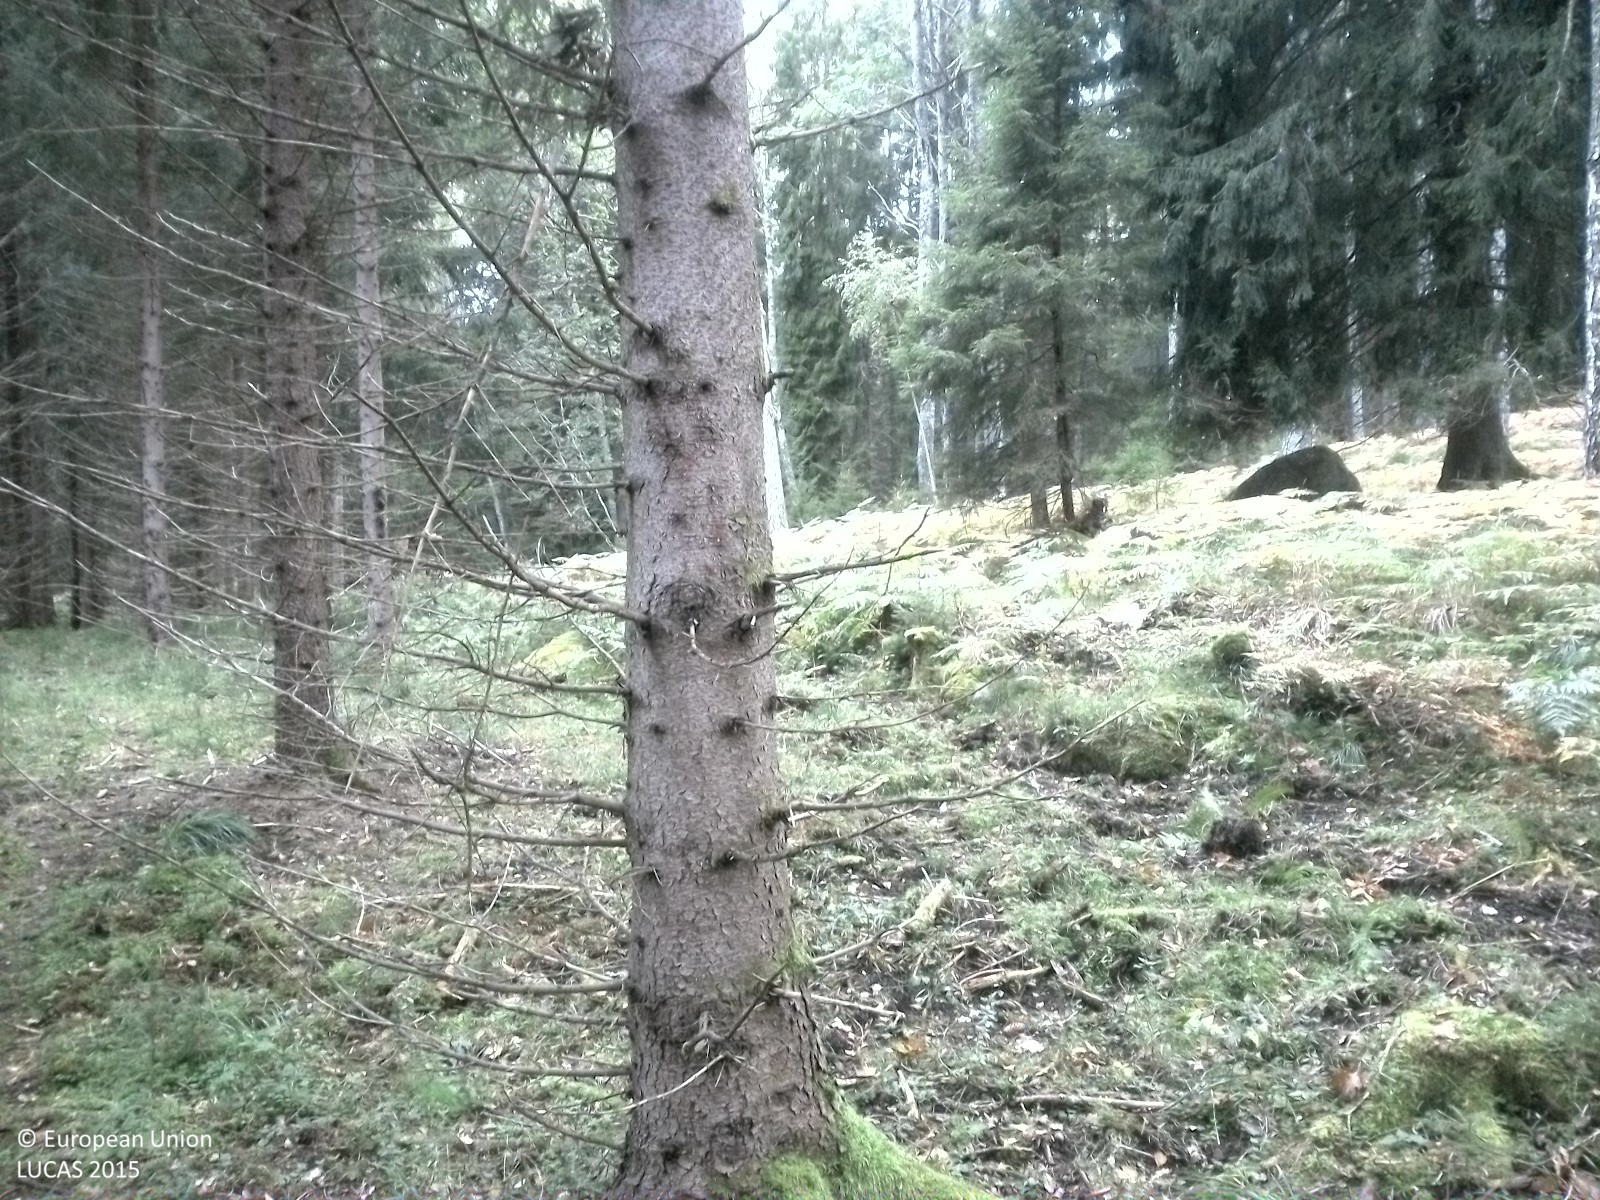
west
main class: Woodland
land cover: Spruce dominated coniferous woodland
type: boreal forest
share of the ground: 50 - 75 %
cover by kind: coniferous forest trees 60 %, lichens and mosses 20 %, herbaceous plants 10 %, unconsolidated bare surface 10 %
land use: Forestry
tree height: > 5 m
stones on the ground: < 10 %
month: September
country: SE
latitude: 58.9073
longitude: 15.7744
